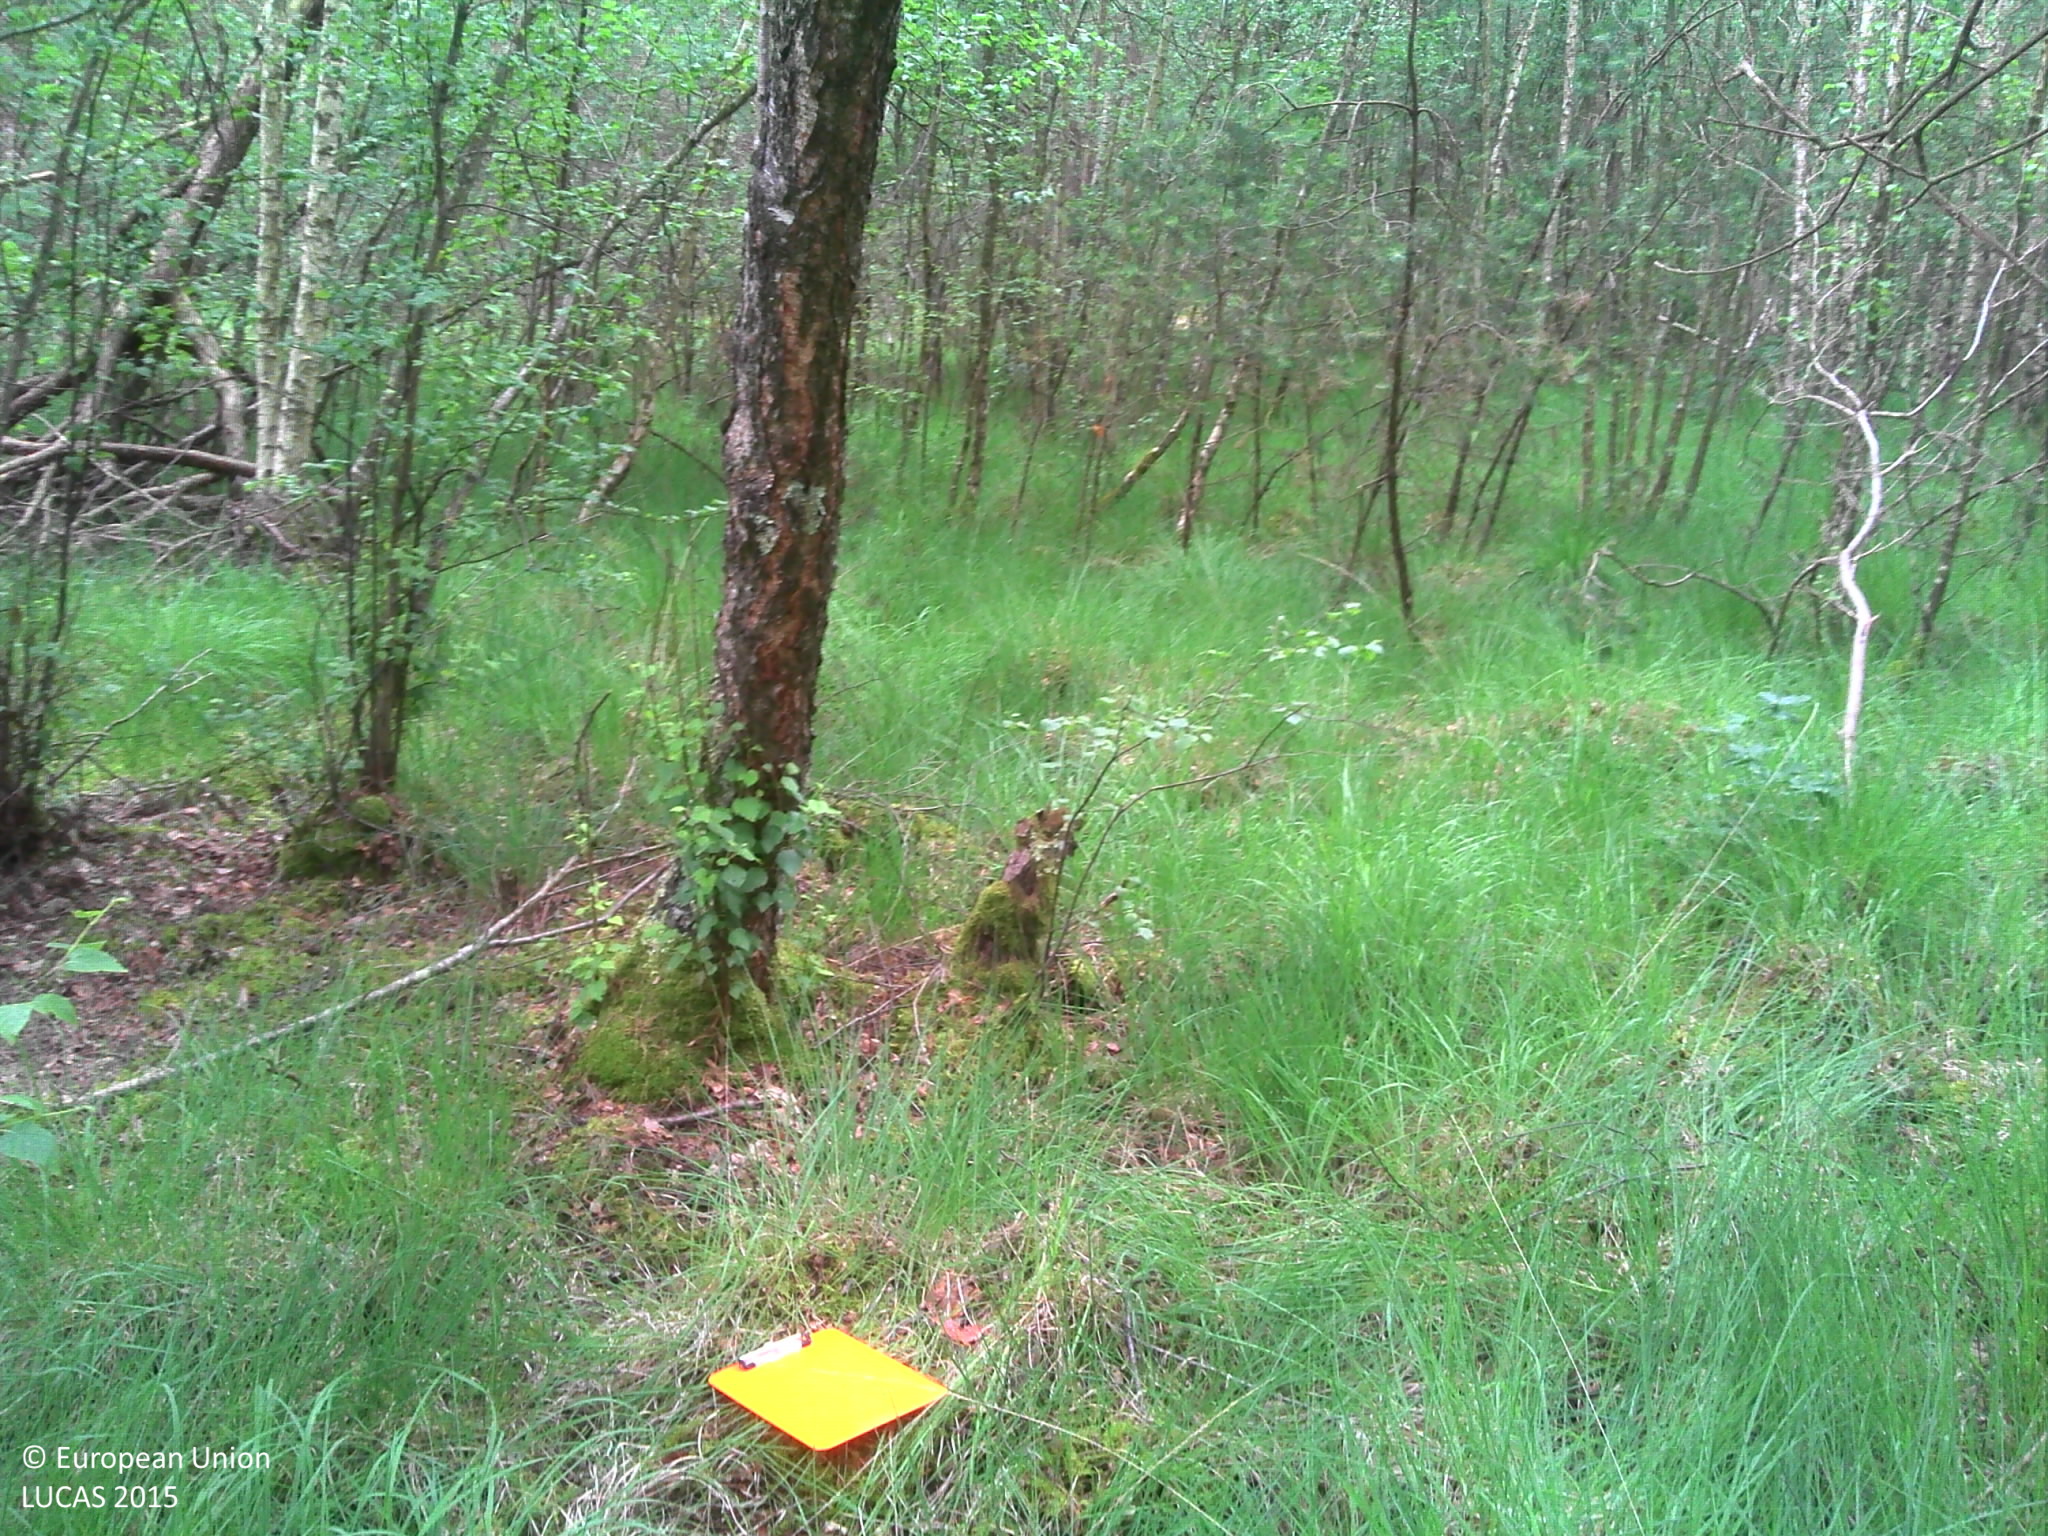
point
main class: Woodland
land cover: Pine dominated mixed woodland
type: thermophilous deciduous forest
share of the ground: > 75 %
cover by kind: herbaceous plants 60 %, coniferous forest trees 15 %, broadleaved forest trees 15 %, lichens and mosses 10 %
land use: Amenities, museums, leisure
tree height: > 5 m
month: June
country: FR
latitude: 47.5211
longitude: 2.0611
